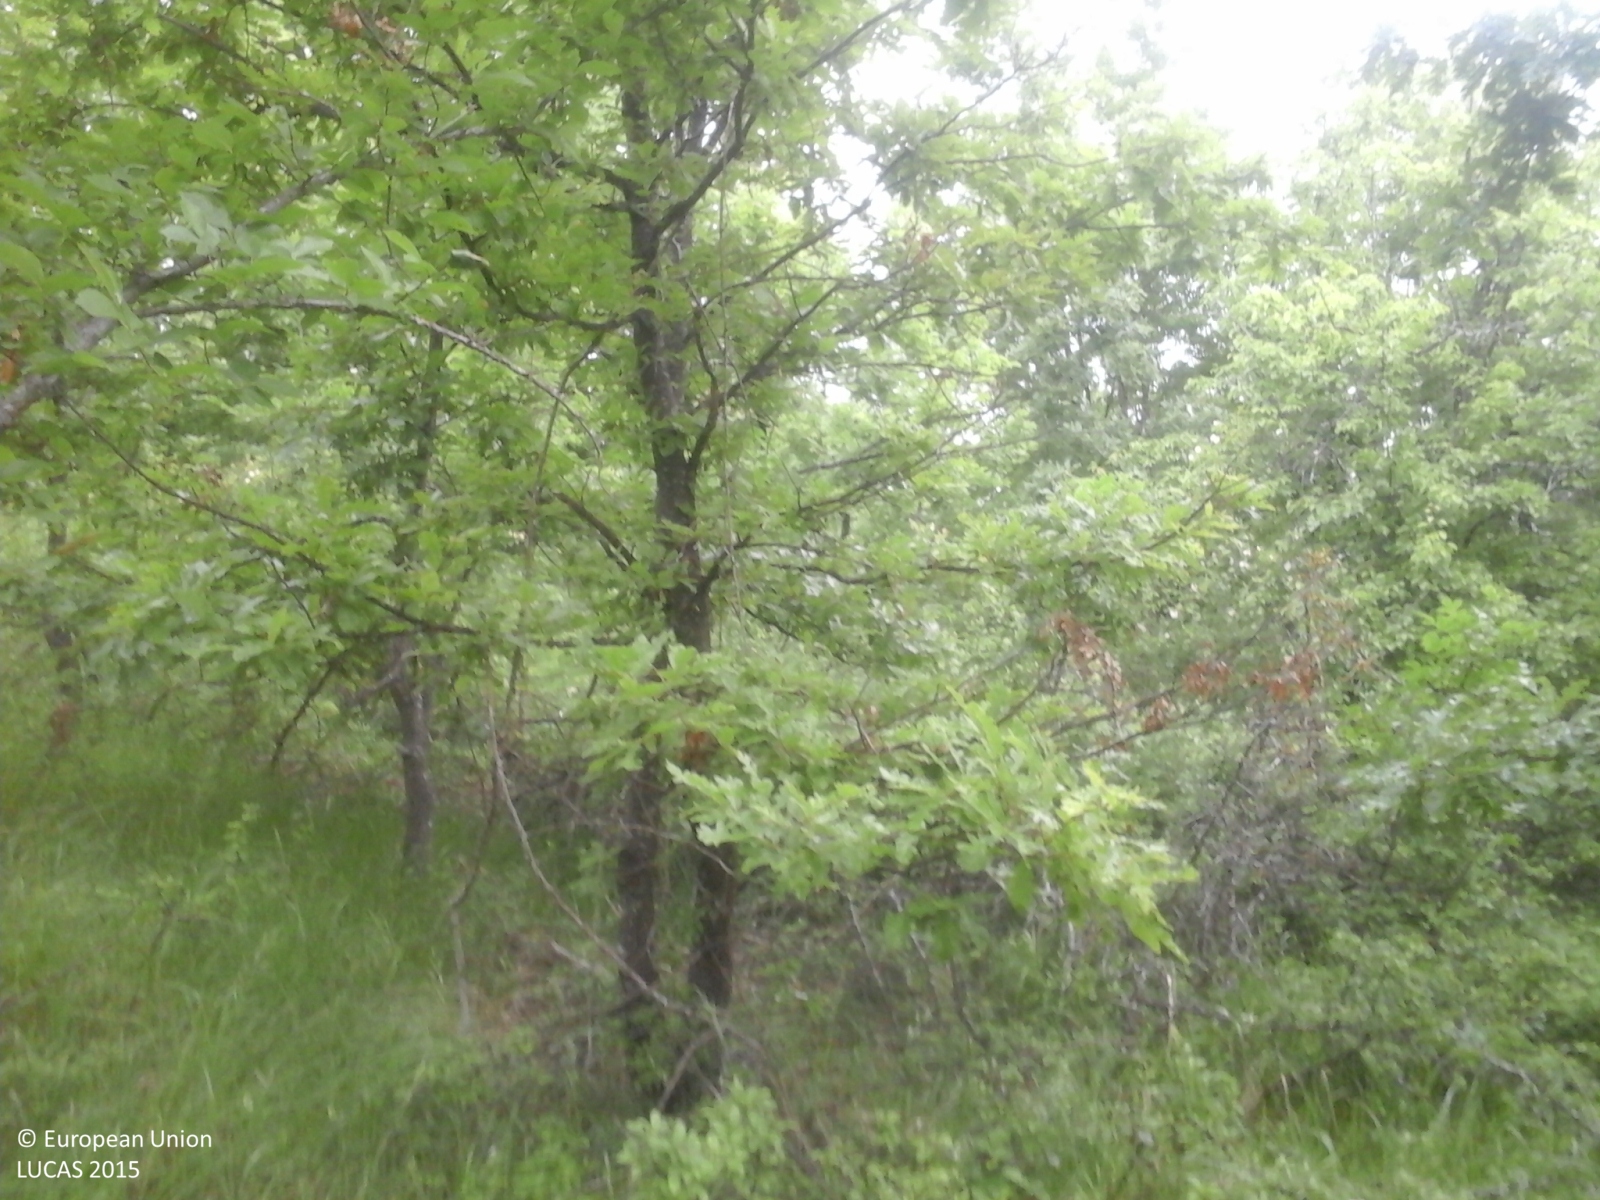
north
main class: Woodland
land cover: Broadleaved woodland
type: thermophilous deciduous forest
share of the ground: > 75 %
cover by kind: broadleaved forest trees 100 %
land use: Forestry
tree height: > 5 m
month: May
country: IT
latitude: 44.2922
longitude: 10.9377
